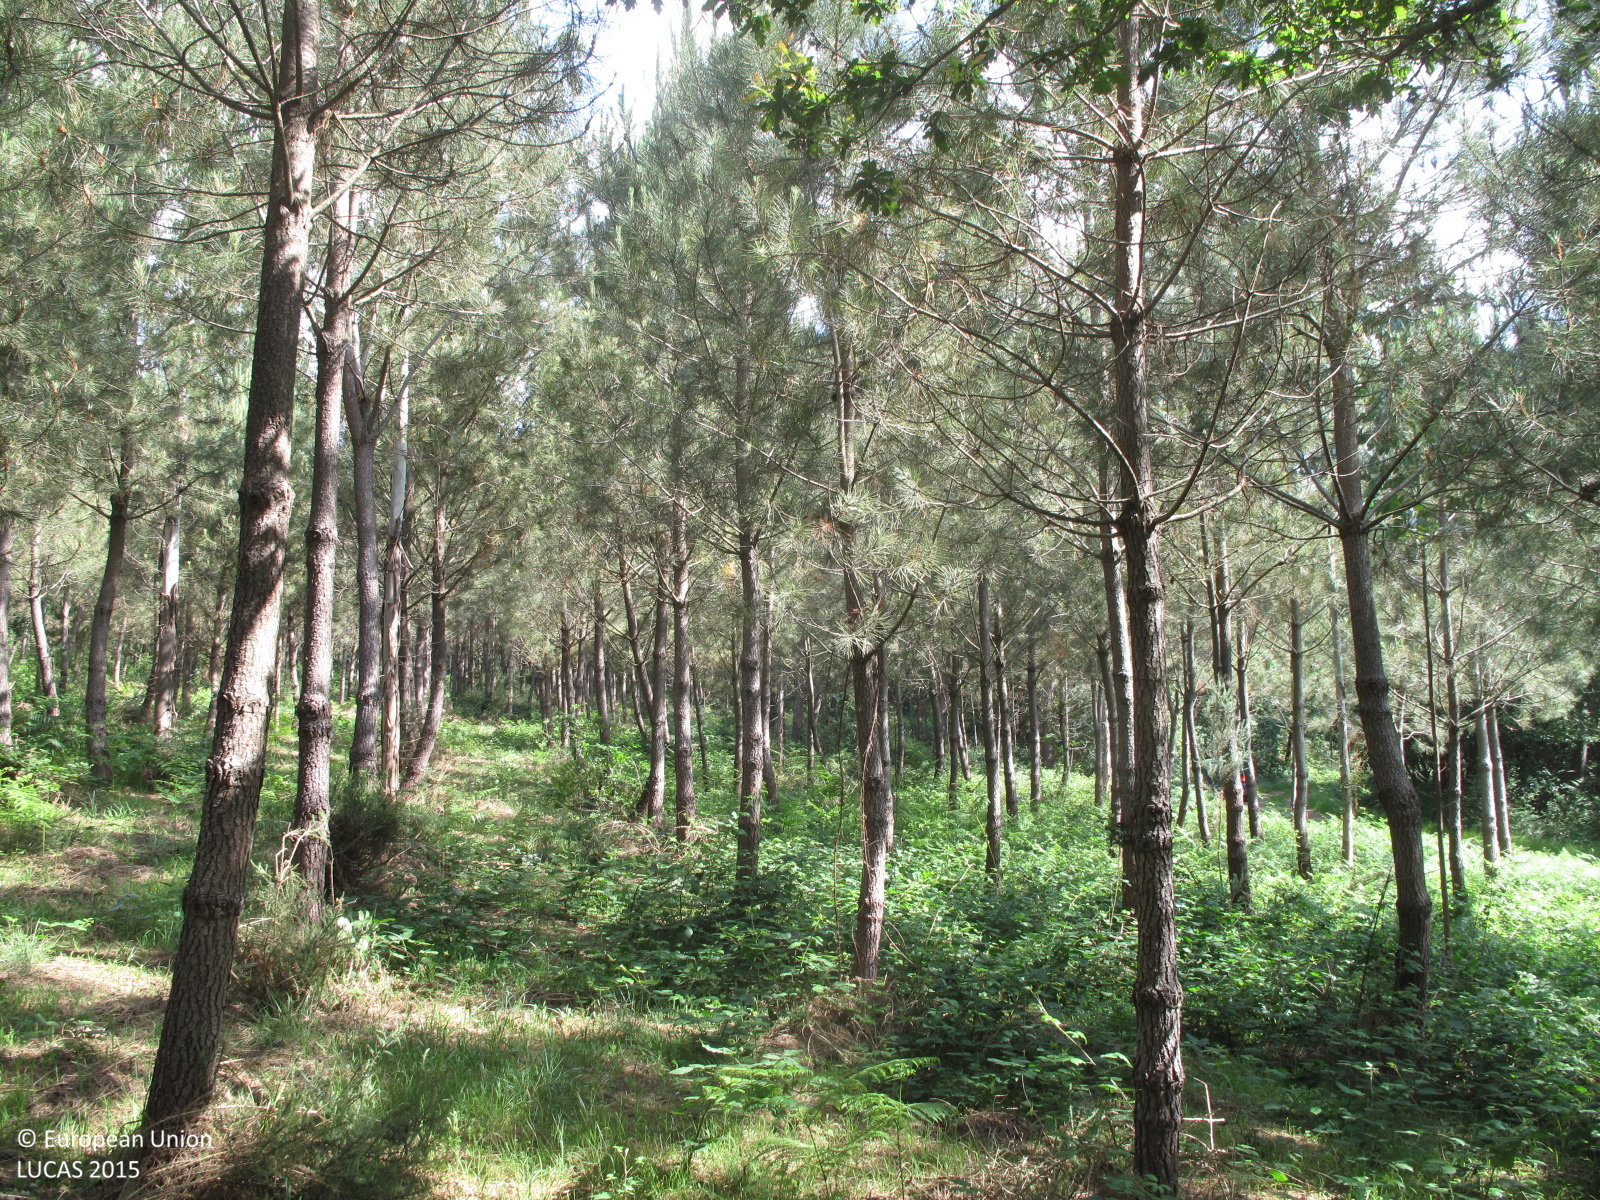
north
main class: Woodland
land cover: Other mixed woodland
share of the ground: > 75 %
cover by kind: coniferous forest trees 50 %, broadleaved forest trees 40 %, shrubs 10 %
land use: Forestry
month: June
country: ES
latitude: 42.9809
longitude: -8.5118
